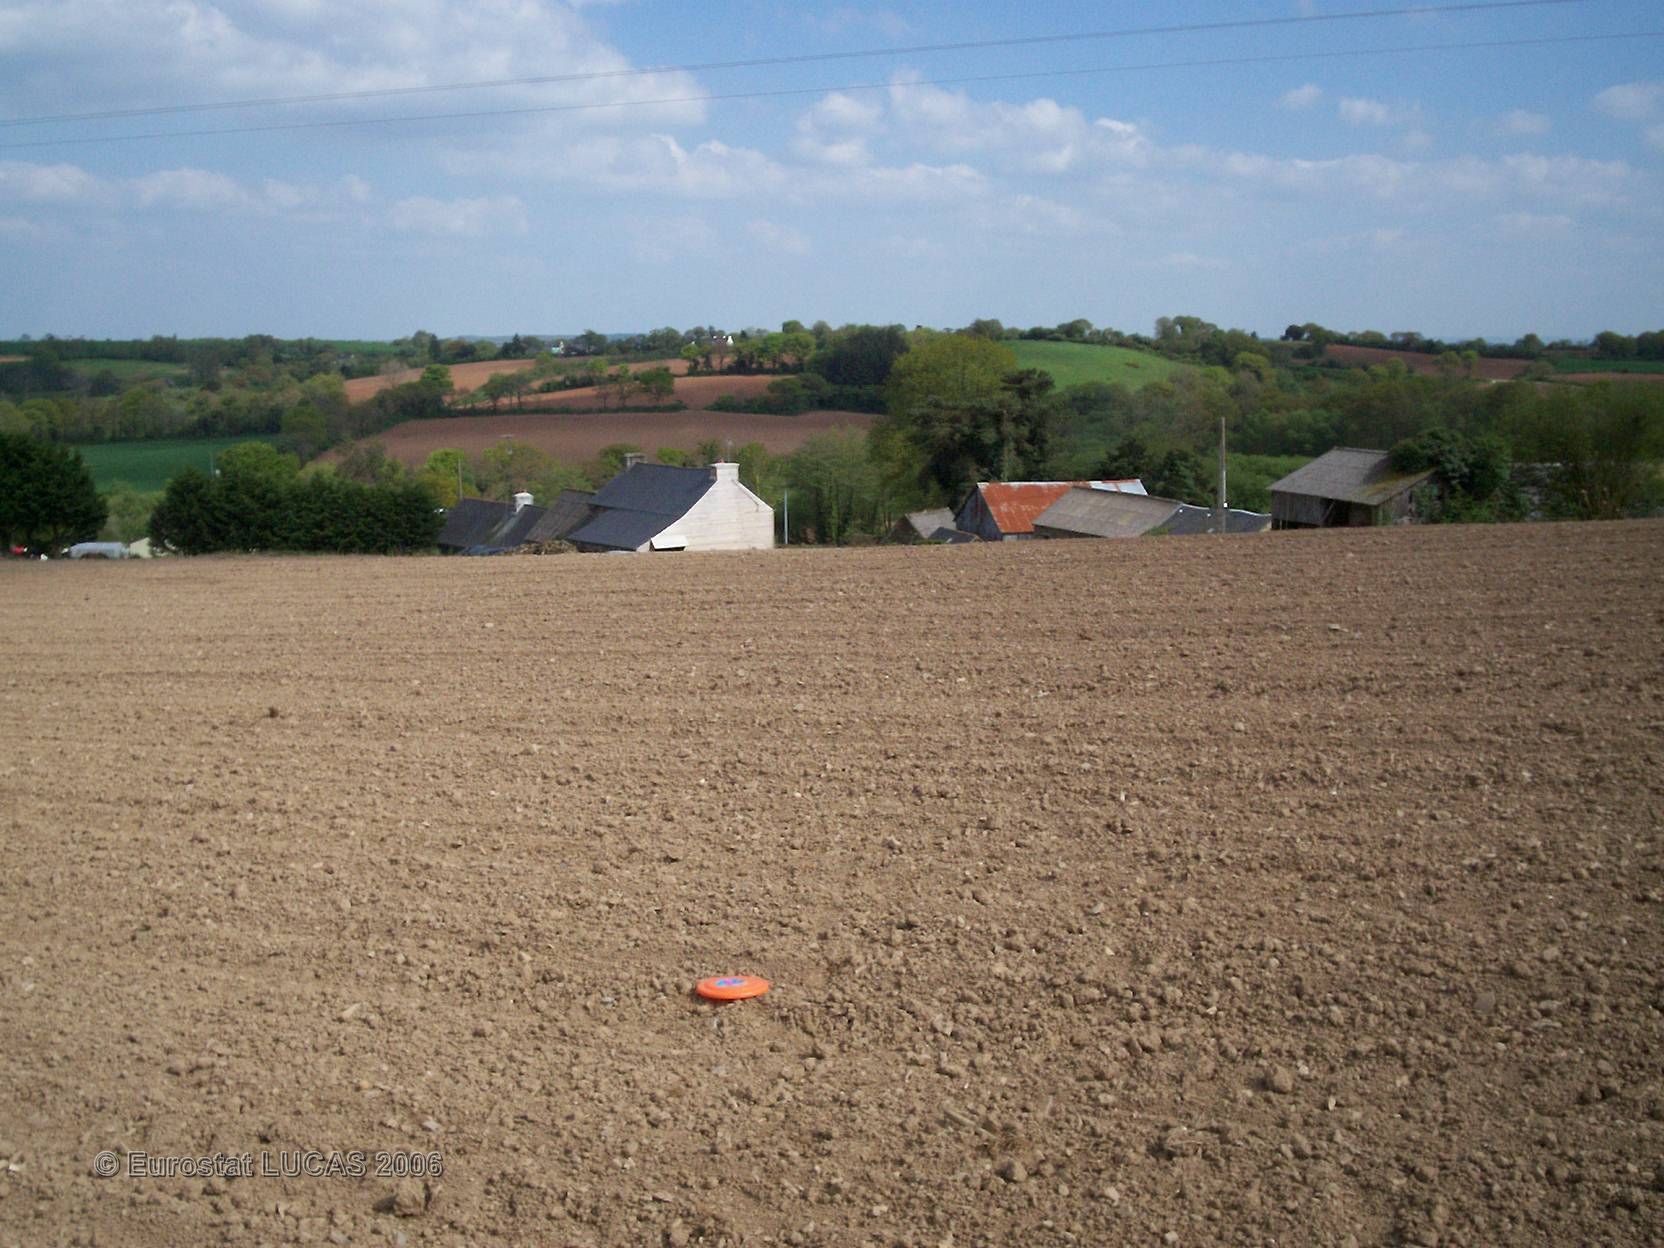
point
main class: Cropland
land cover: Maize
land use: Agriculture (excluding fallow land and kitchen gardens)
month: May
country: FR
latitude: 48.4085
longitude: -3.6585
